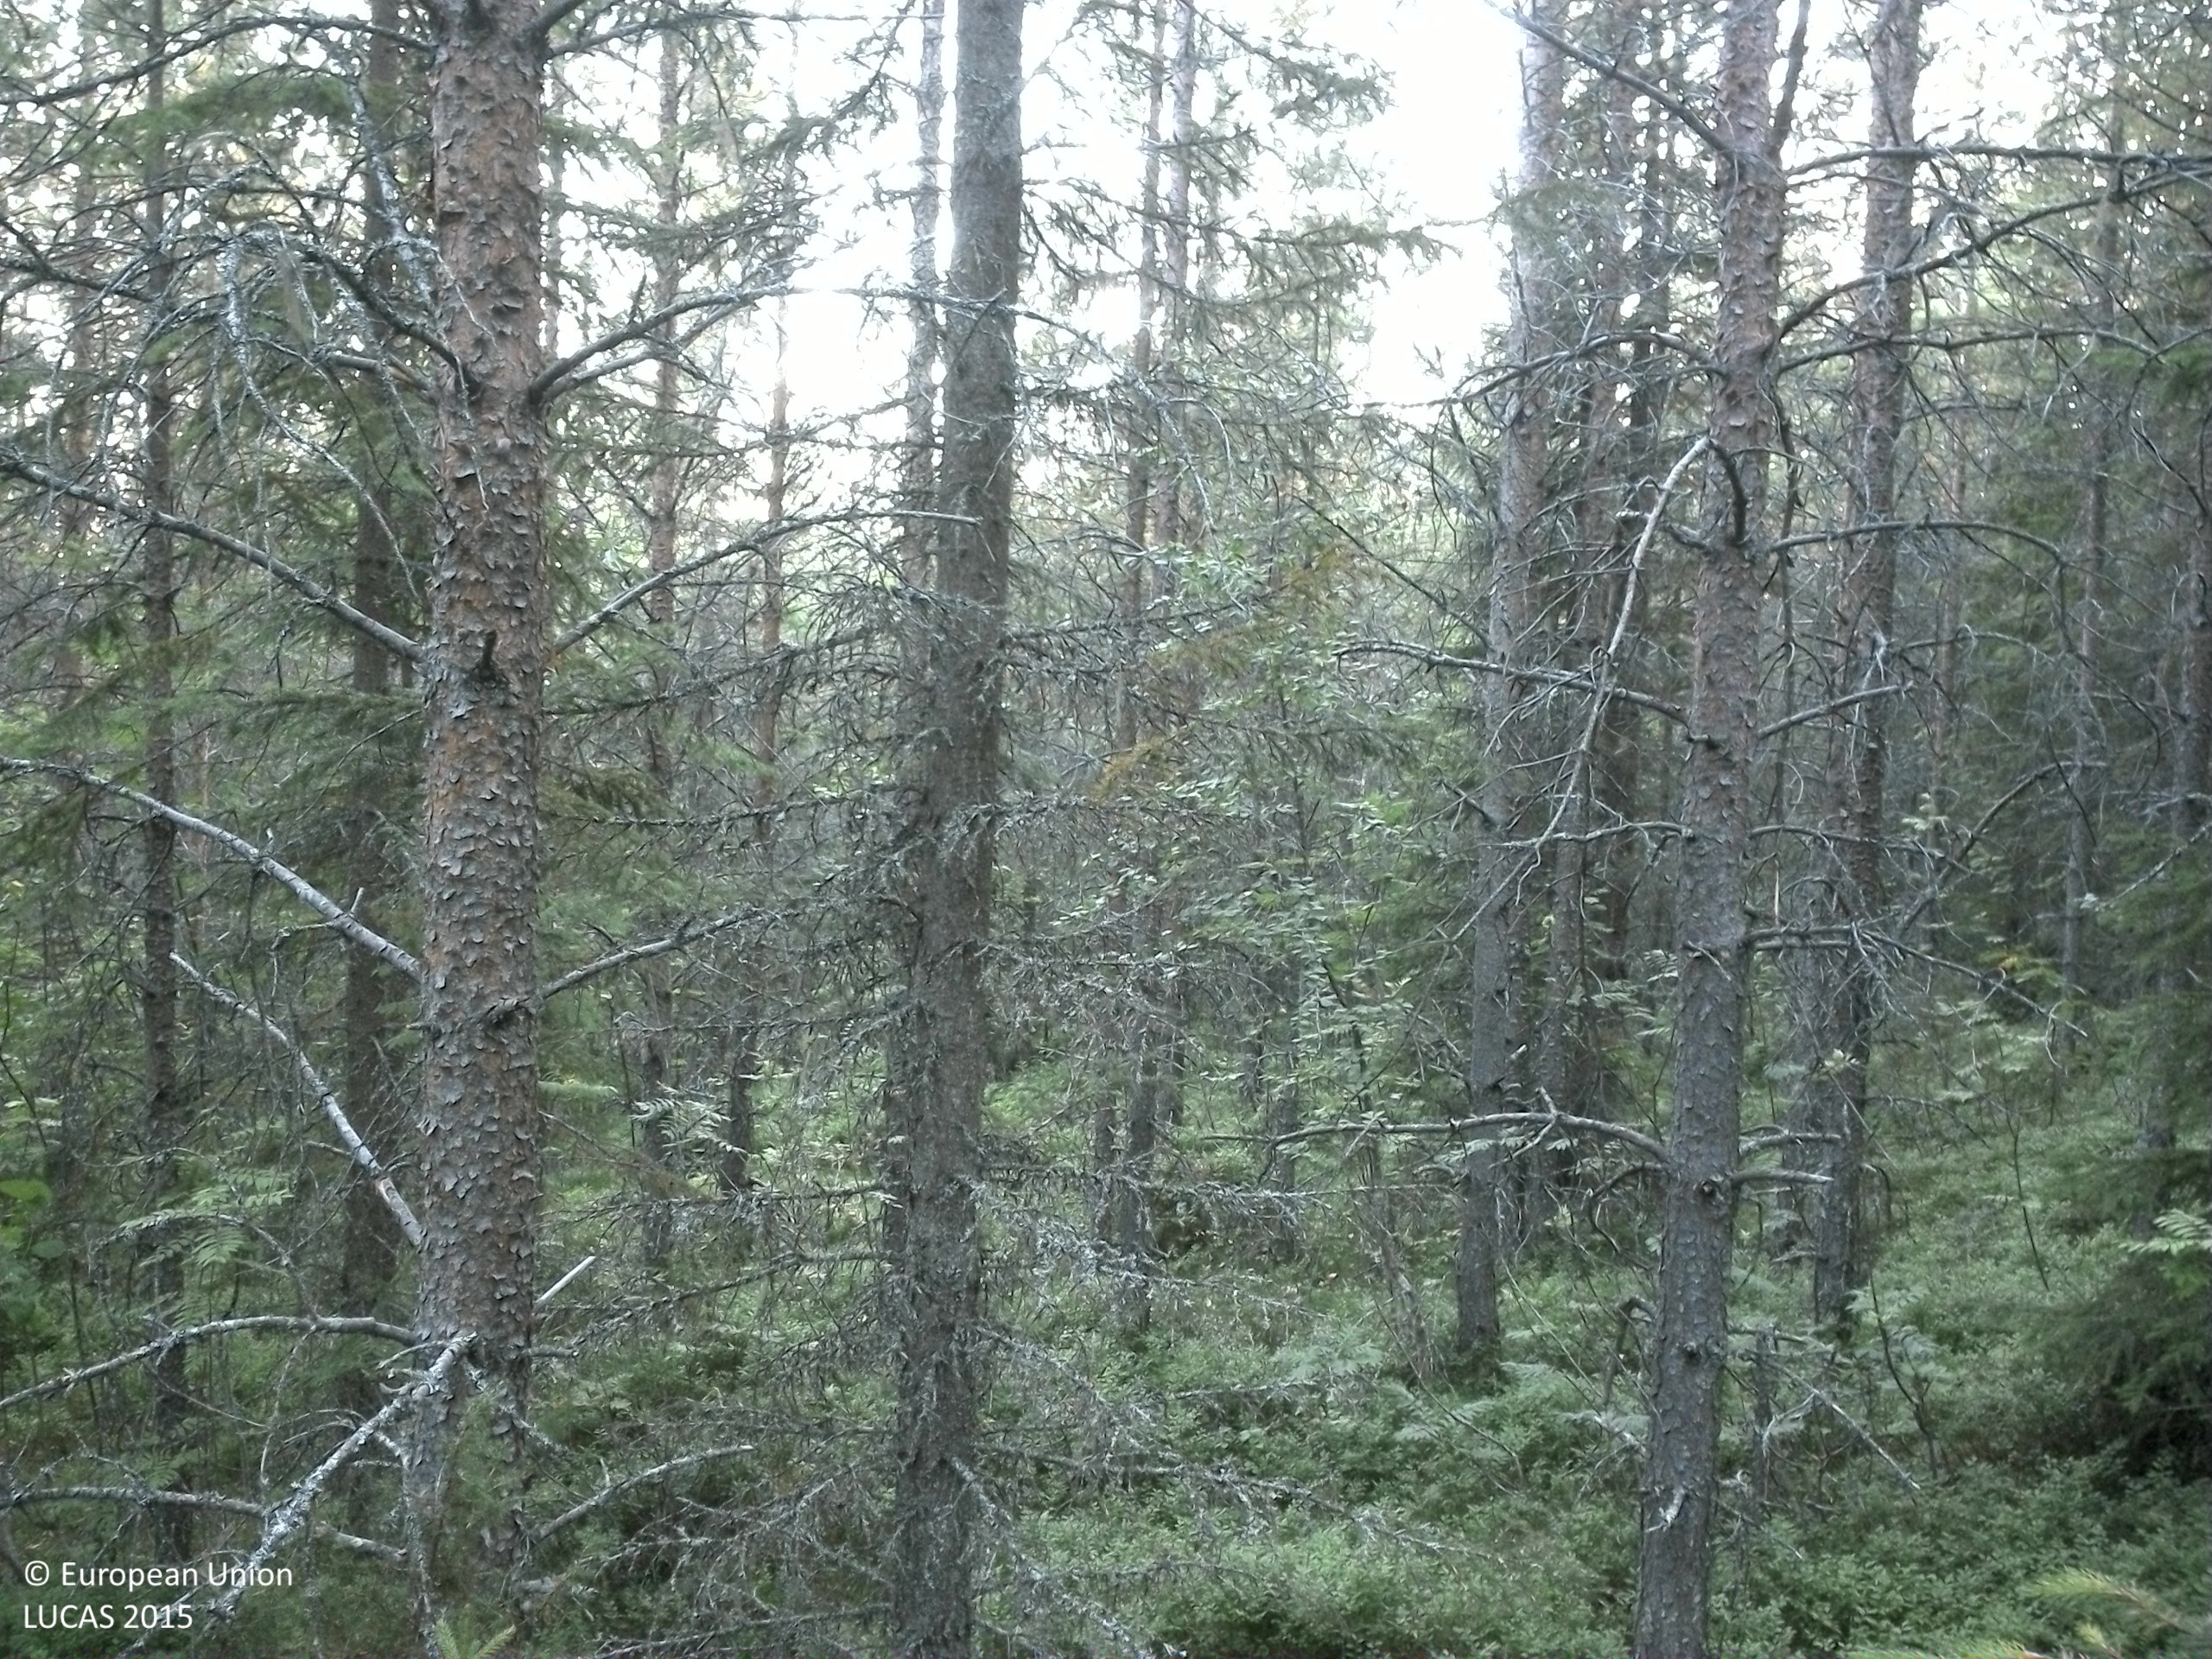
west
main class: Woodland
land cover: Pine dominated coniferous woodland
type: exotic forest
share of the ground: 50 - 75 %
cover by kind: coniferous forest trees 50 %, shrubs 45 %, broadleaved forest trees 5 %
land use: Forestry
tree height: > 5 m
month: August
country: SE
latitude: 63.7372
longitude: 17.3657
